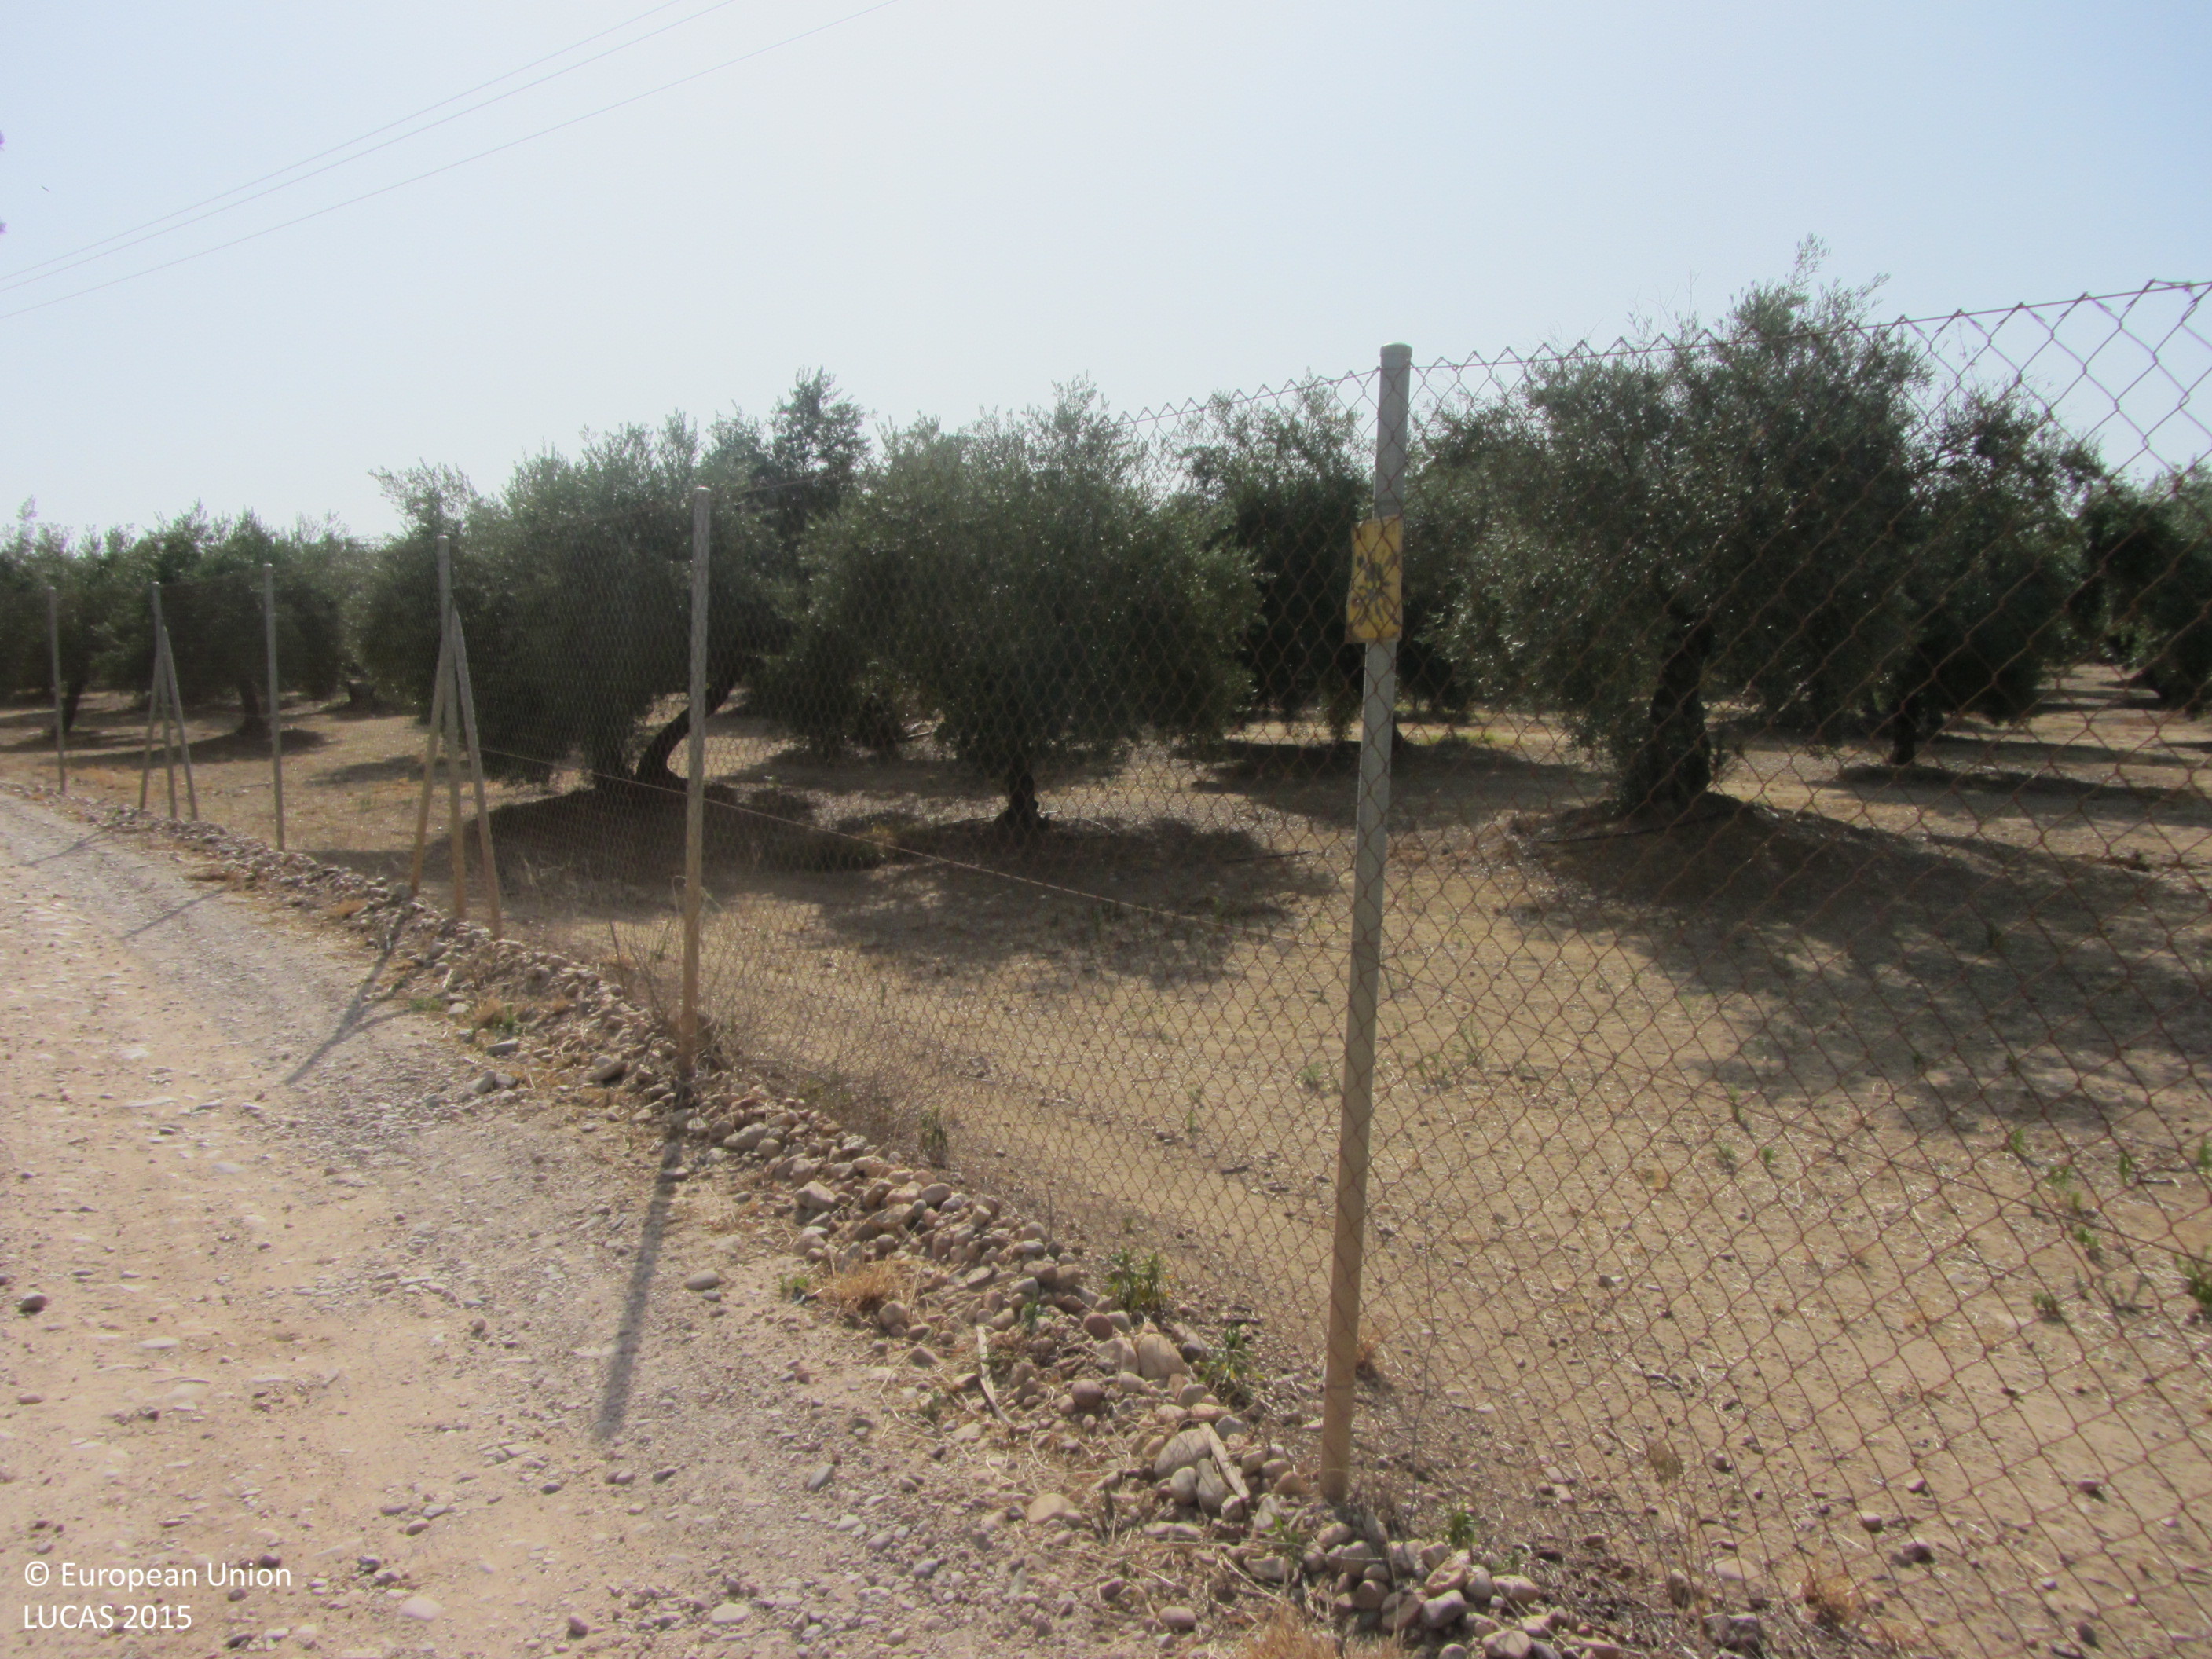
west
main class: Cropland
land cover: Olive groves
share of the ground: 50 - 75 %
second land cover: Other bare soil
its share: > 75 %
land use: Agriculture (excluding fallow land and kitchen gardens)
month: July
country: ES
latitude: 38.1008
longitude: -3.8850
